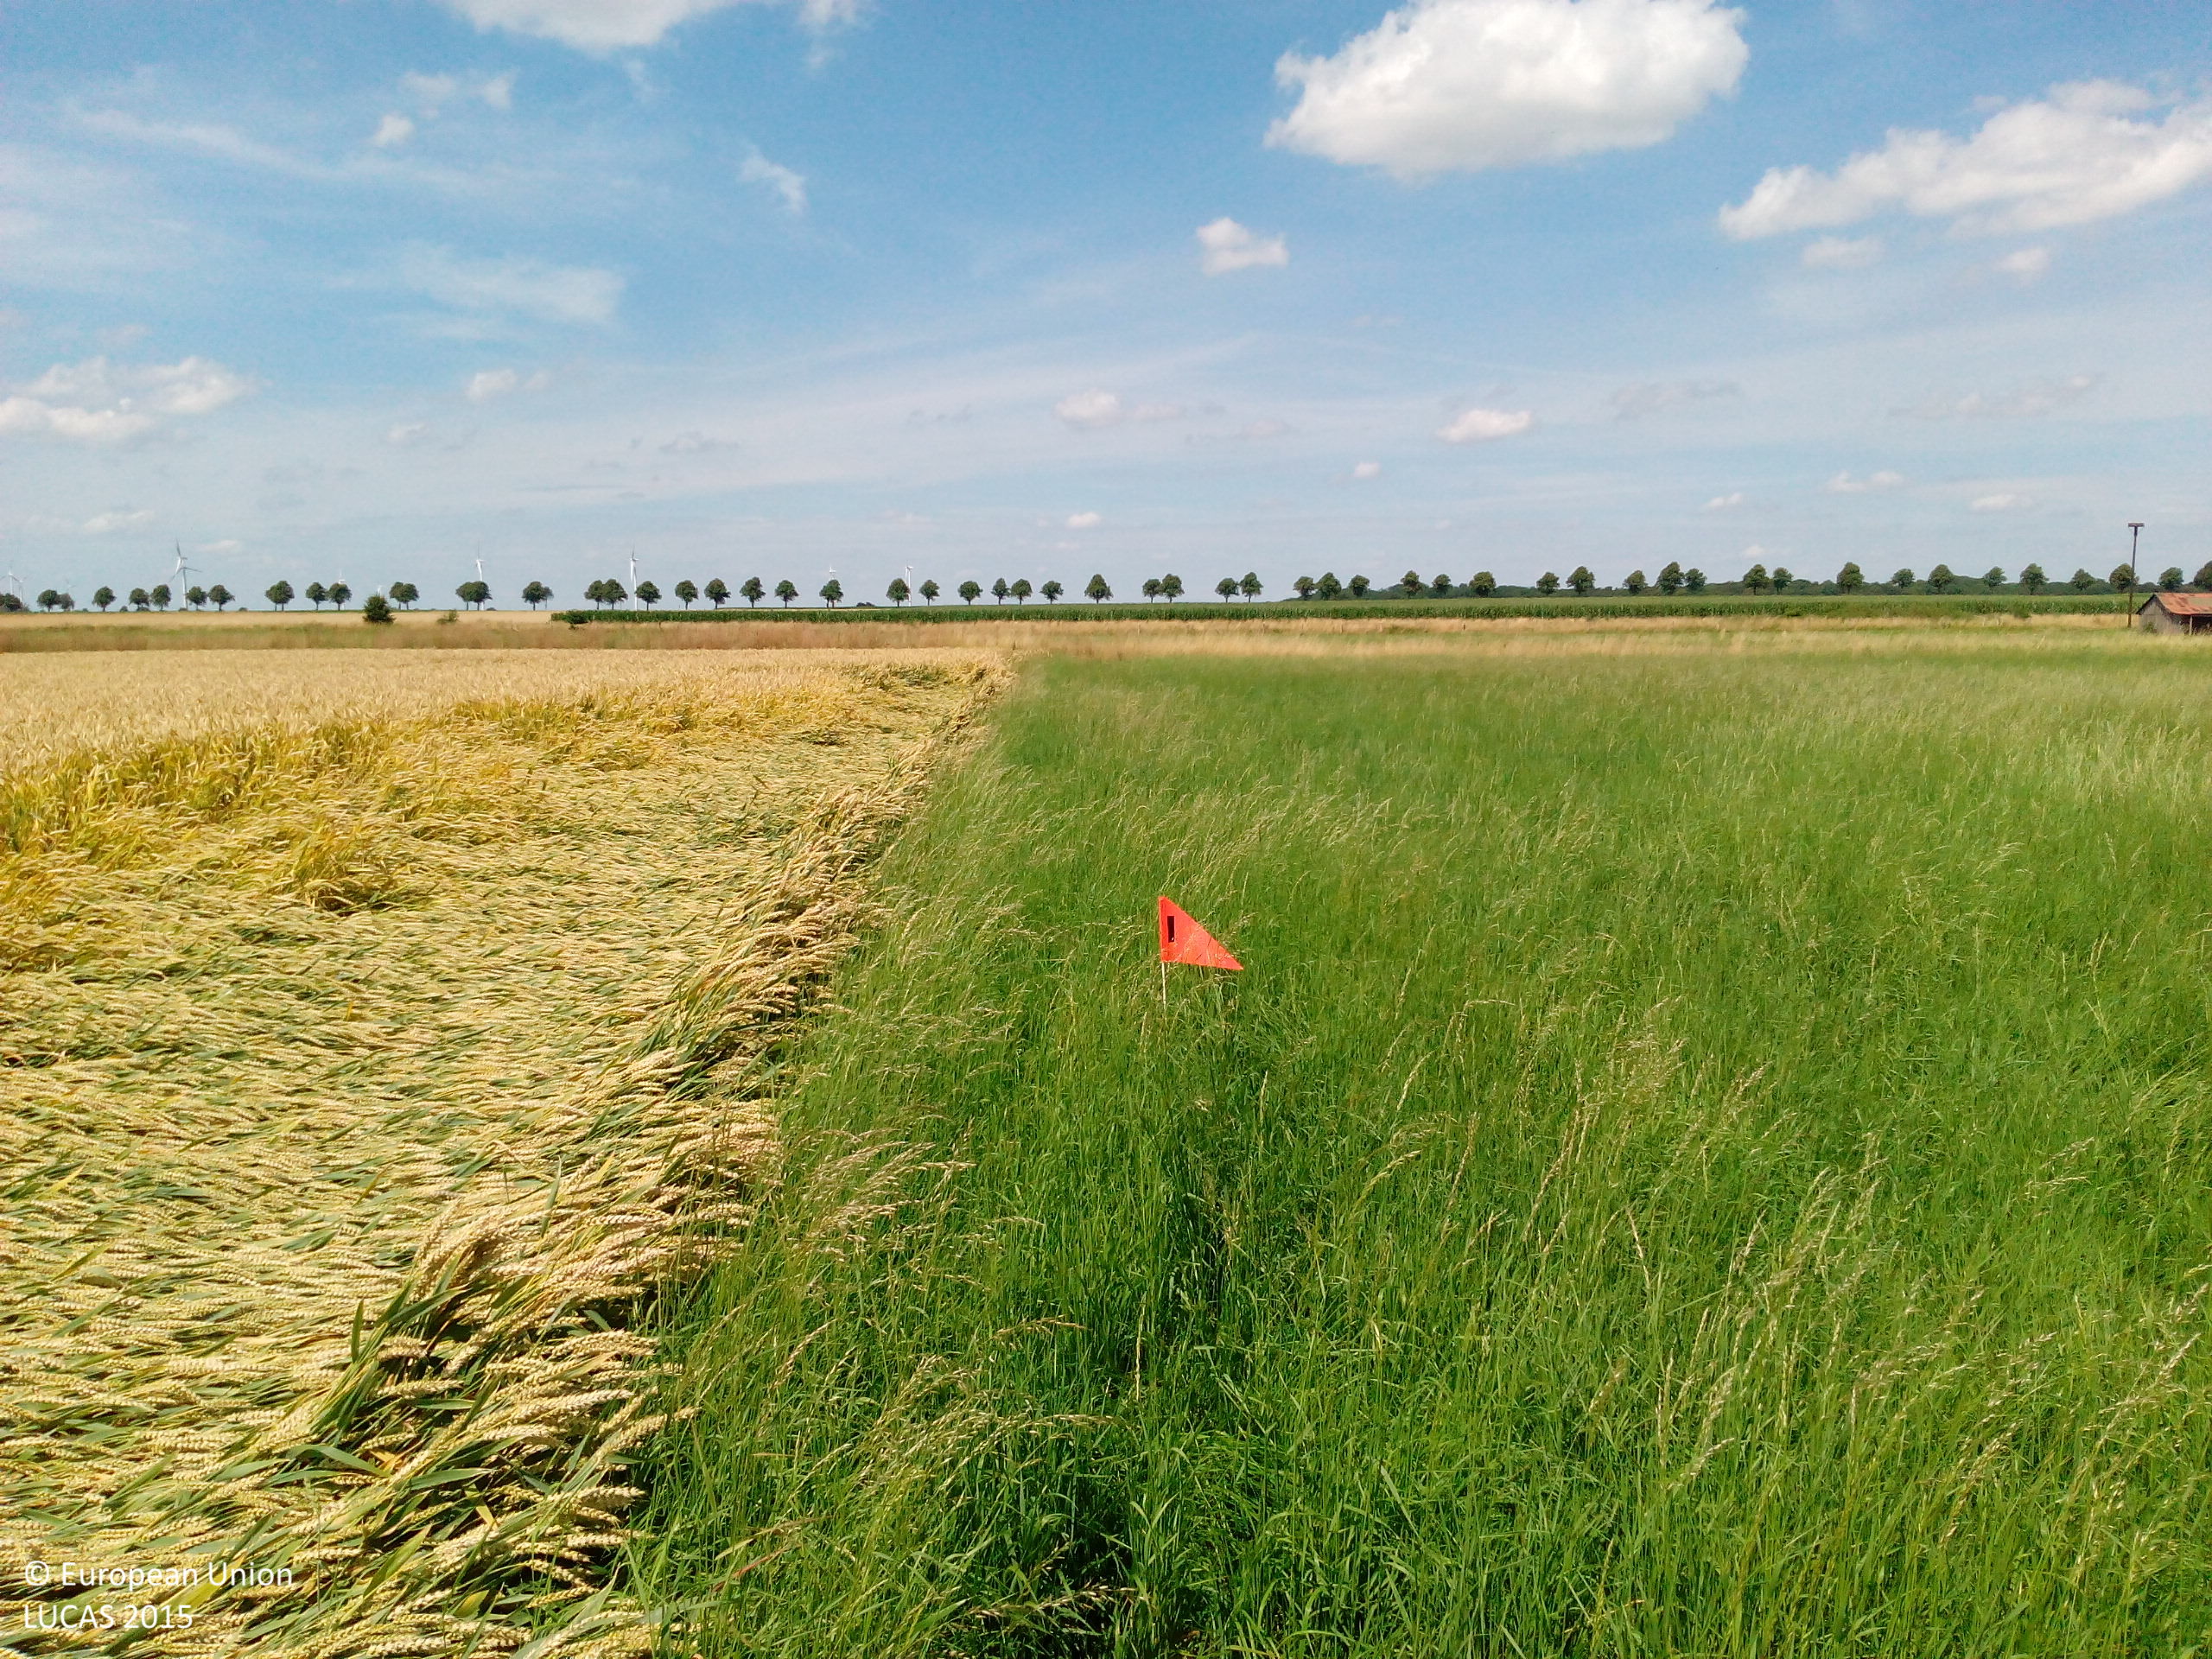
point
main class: Grassland
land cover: Grassland without tree/shrub cover
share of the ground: > 75 %
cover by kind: herbaceous plants 100 %
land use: Agriculture (excluding fallow land and kitchen gardens)
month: July
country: DE
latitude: 52.2154
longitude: 10.2780
